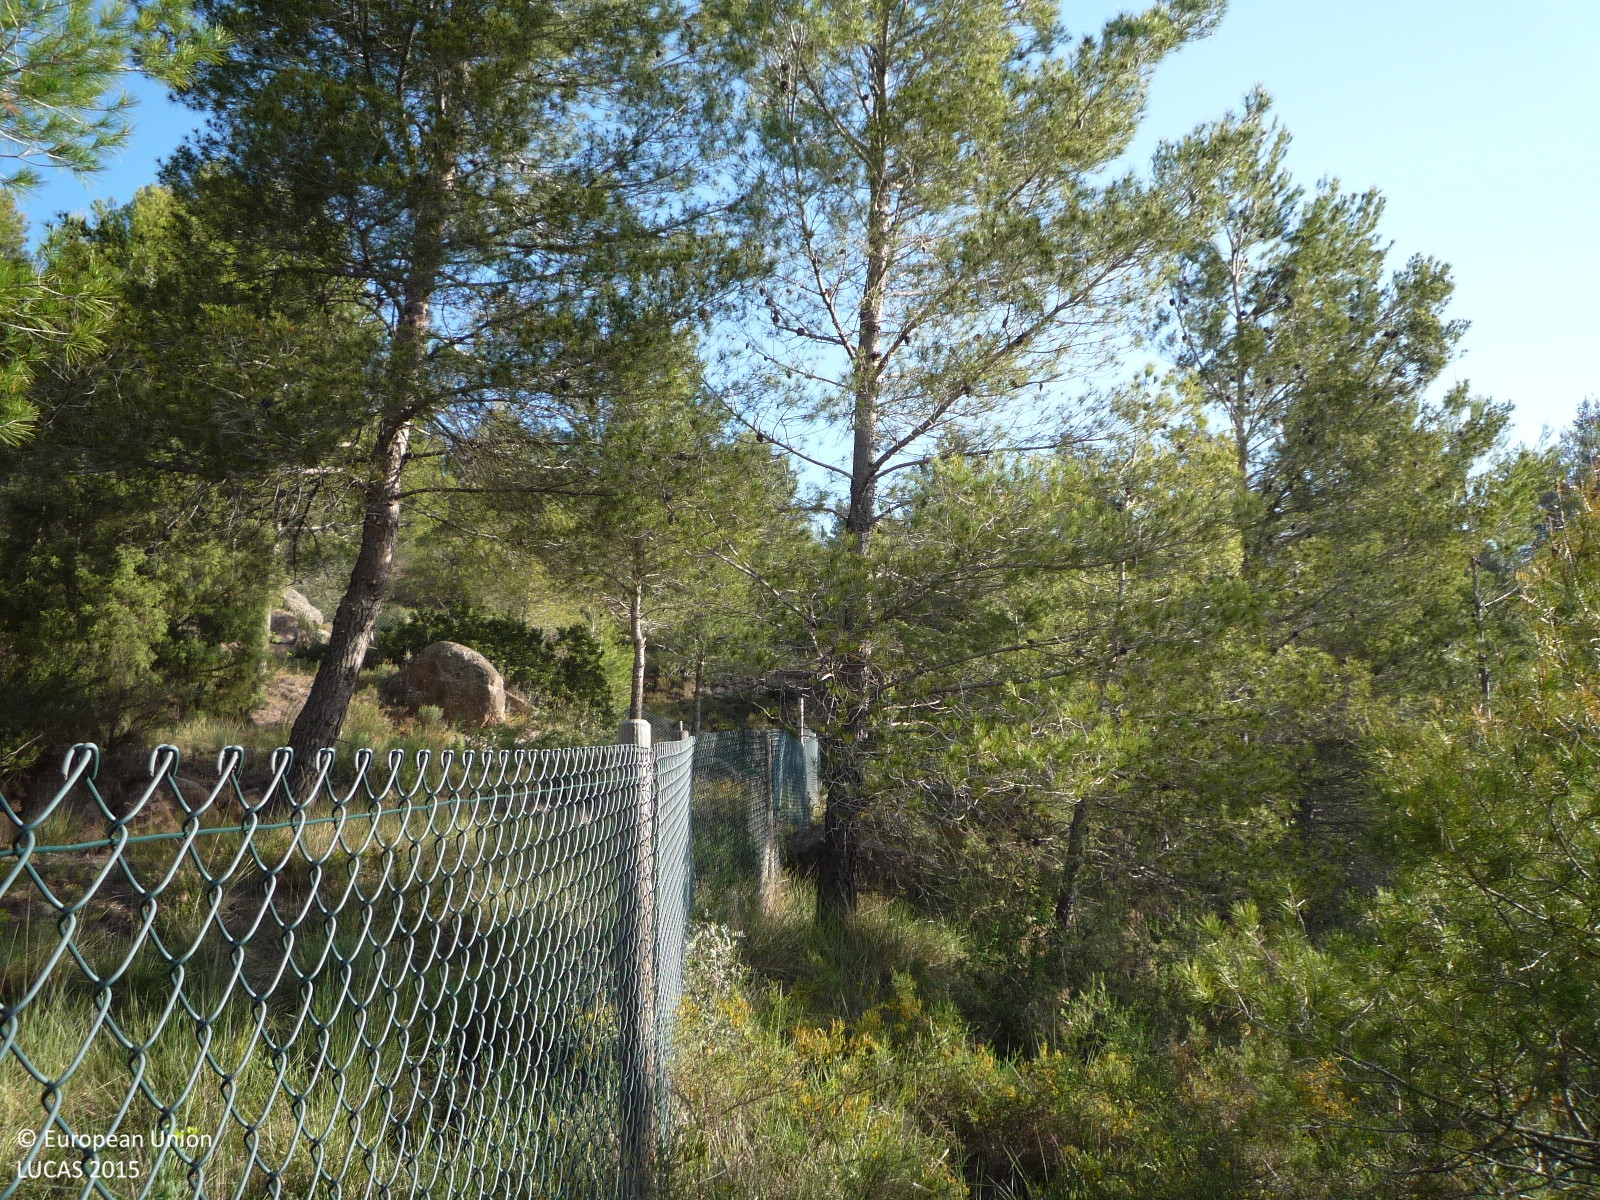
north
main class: Woodland
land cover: Pine dominated coniferous woodland
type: coniferous forest of the mediterranean region
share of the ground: > 75 %
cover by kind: coniferous forest trees 75 %, shrubs 25 %
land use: Residential
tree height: > 5 m
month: April
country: ES
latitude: 41.7187
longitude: 1.7573
